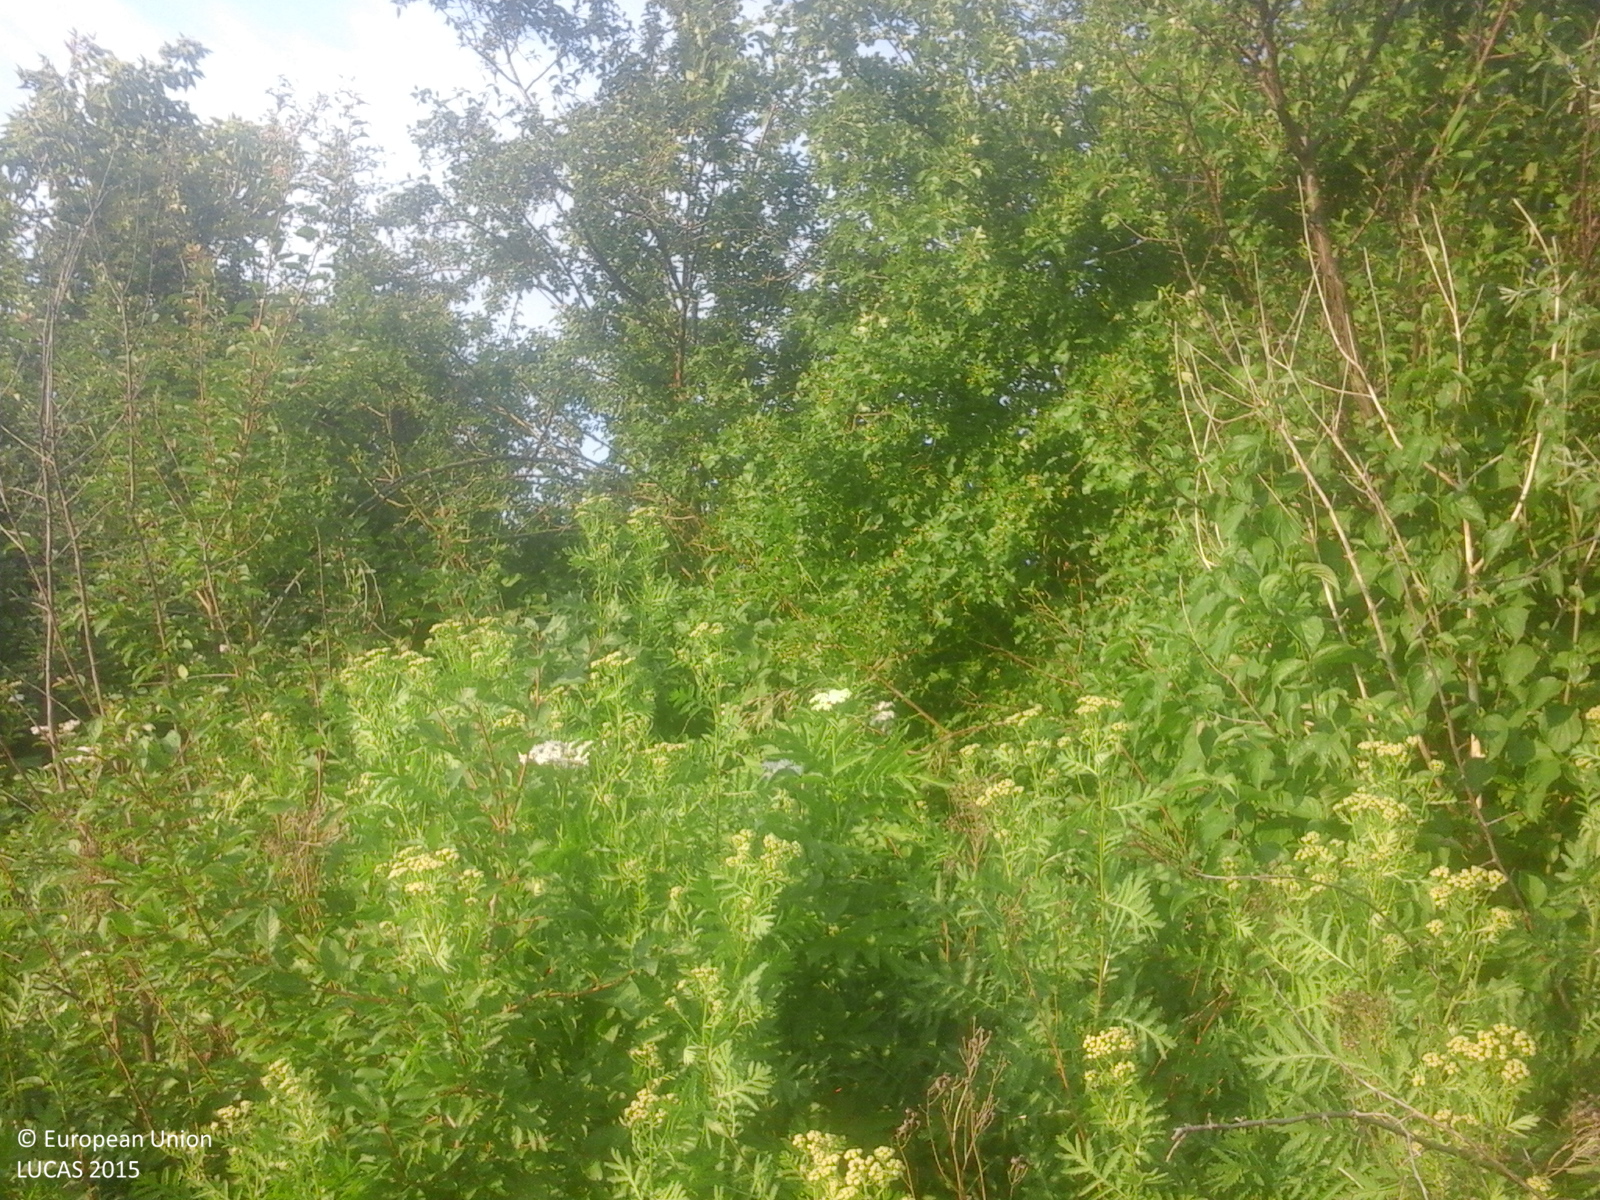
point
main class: Shrubland
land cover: Shrubland with sparse tree cover
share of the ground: > 75 %
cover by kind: shrubs 95 %, broadleaved forest trees 5 %
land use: Semi-natural and natural areas not in use
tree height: < 5 m
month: June
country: RO
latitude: 46.7442
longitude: 27.7782
